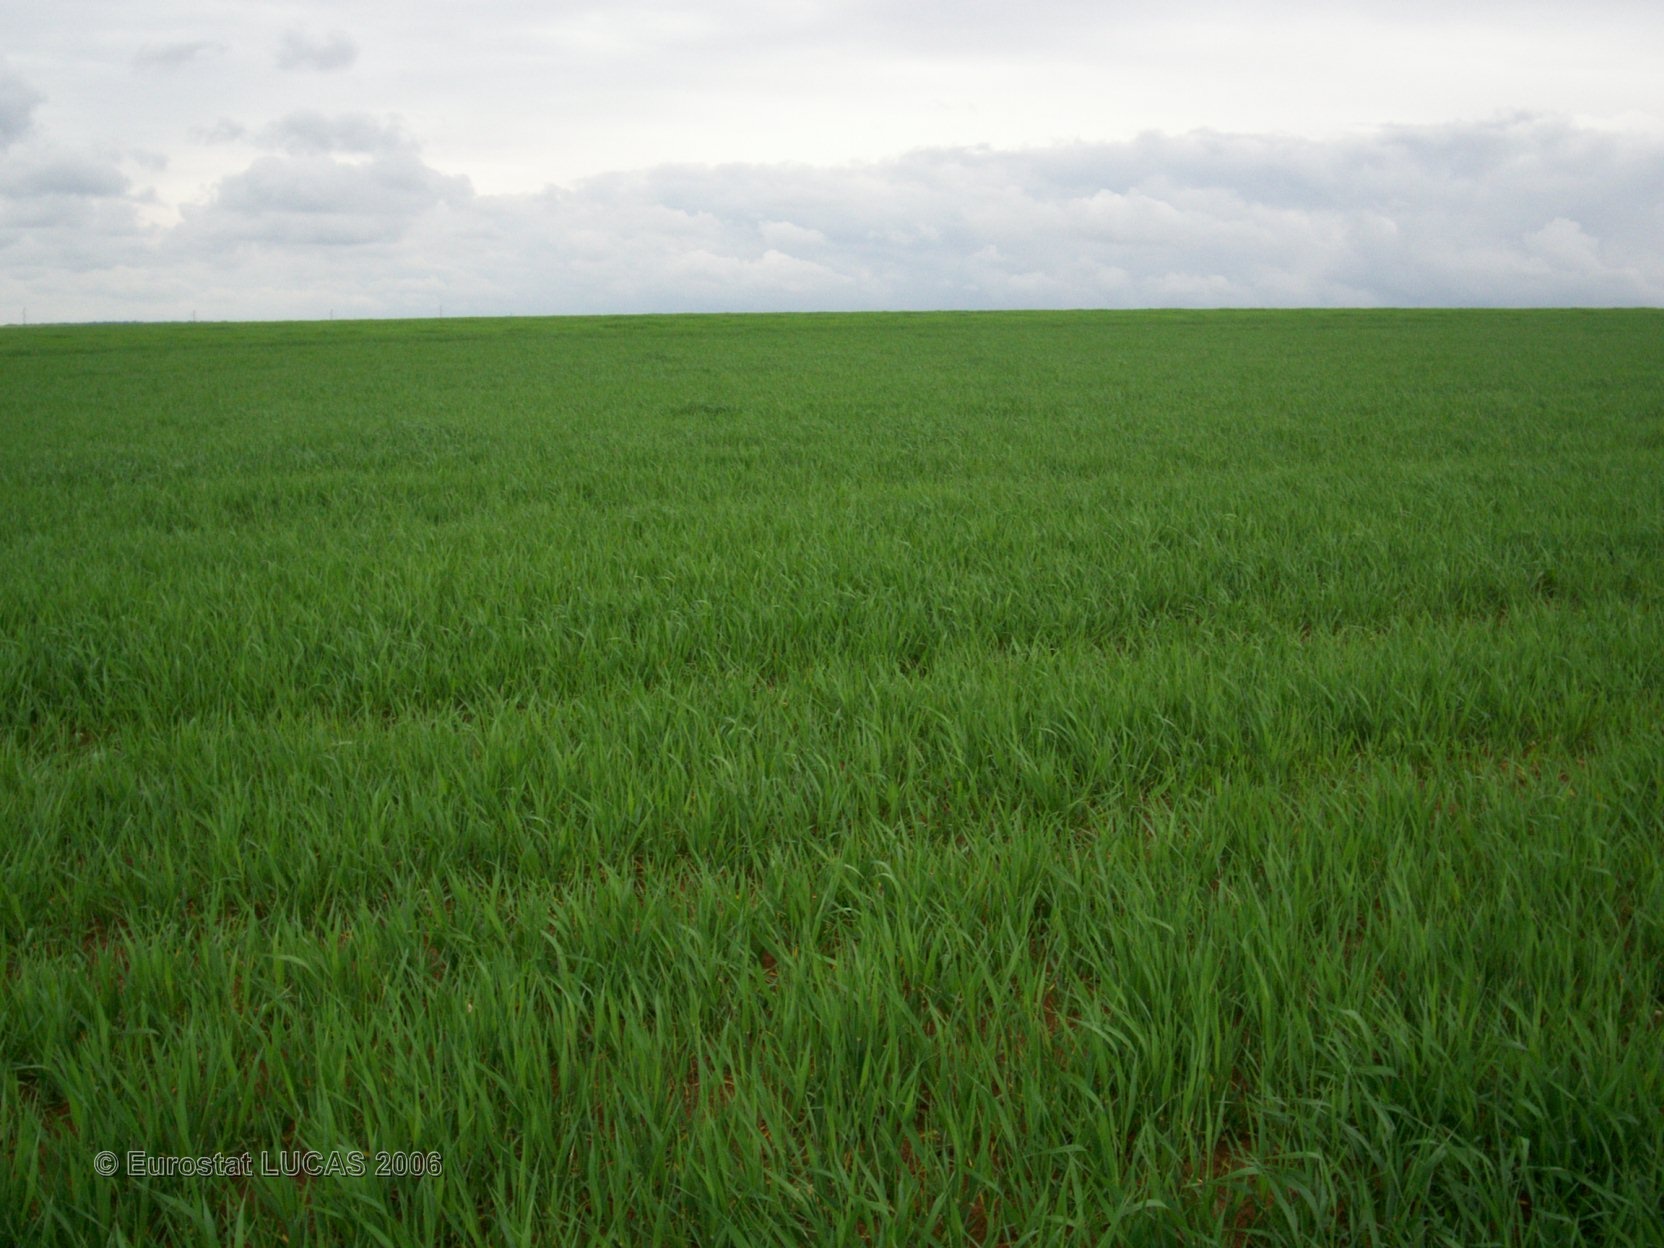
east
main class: Cropland
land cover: Barley
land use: Agriculture (excluding fallow land and kitchen gardens)
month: May
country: FR
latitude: 48.1750
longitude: 4.4705
